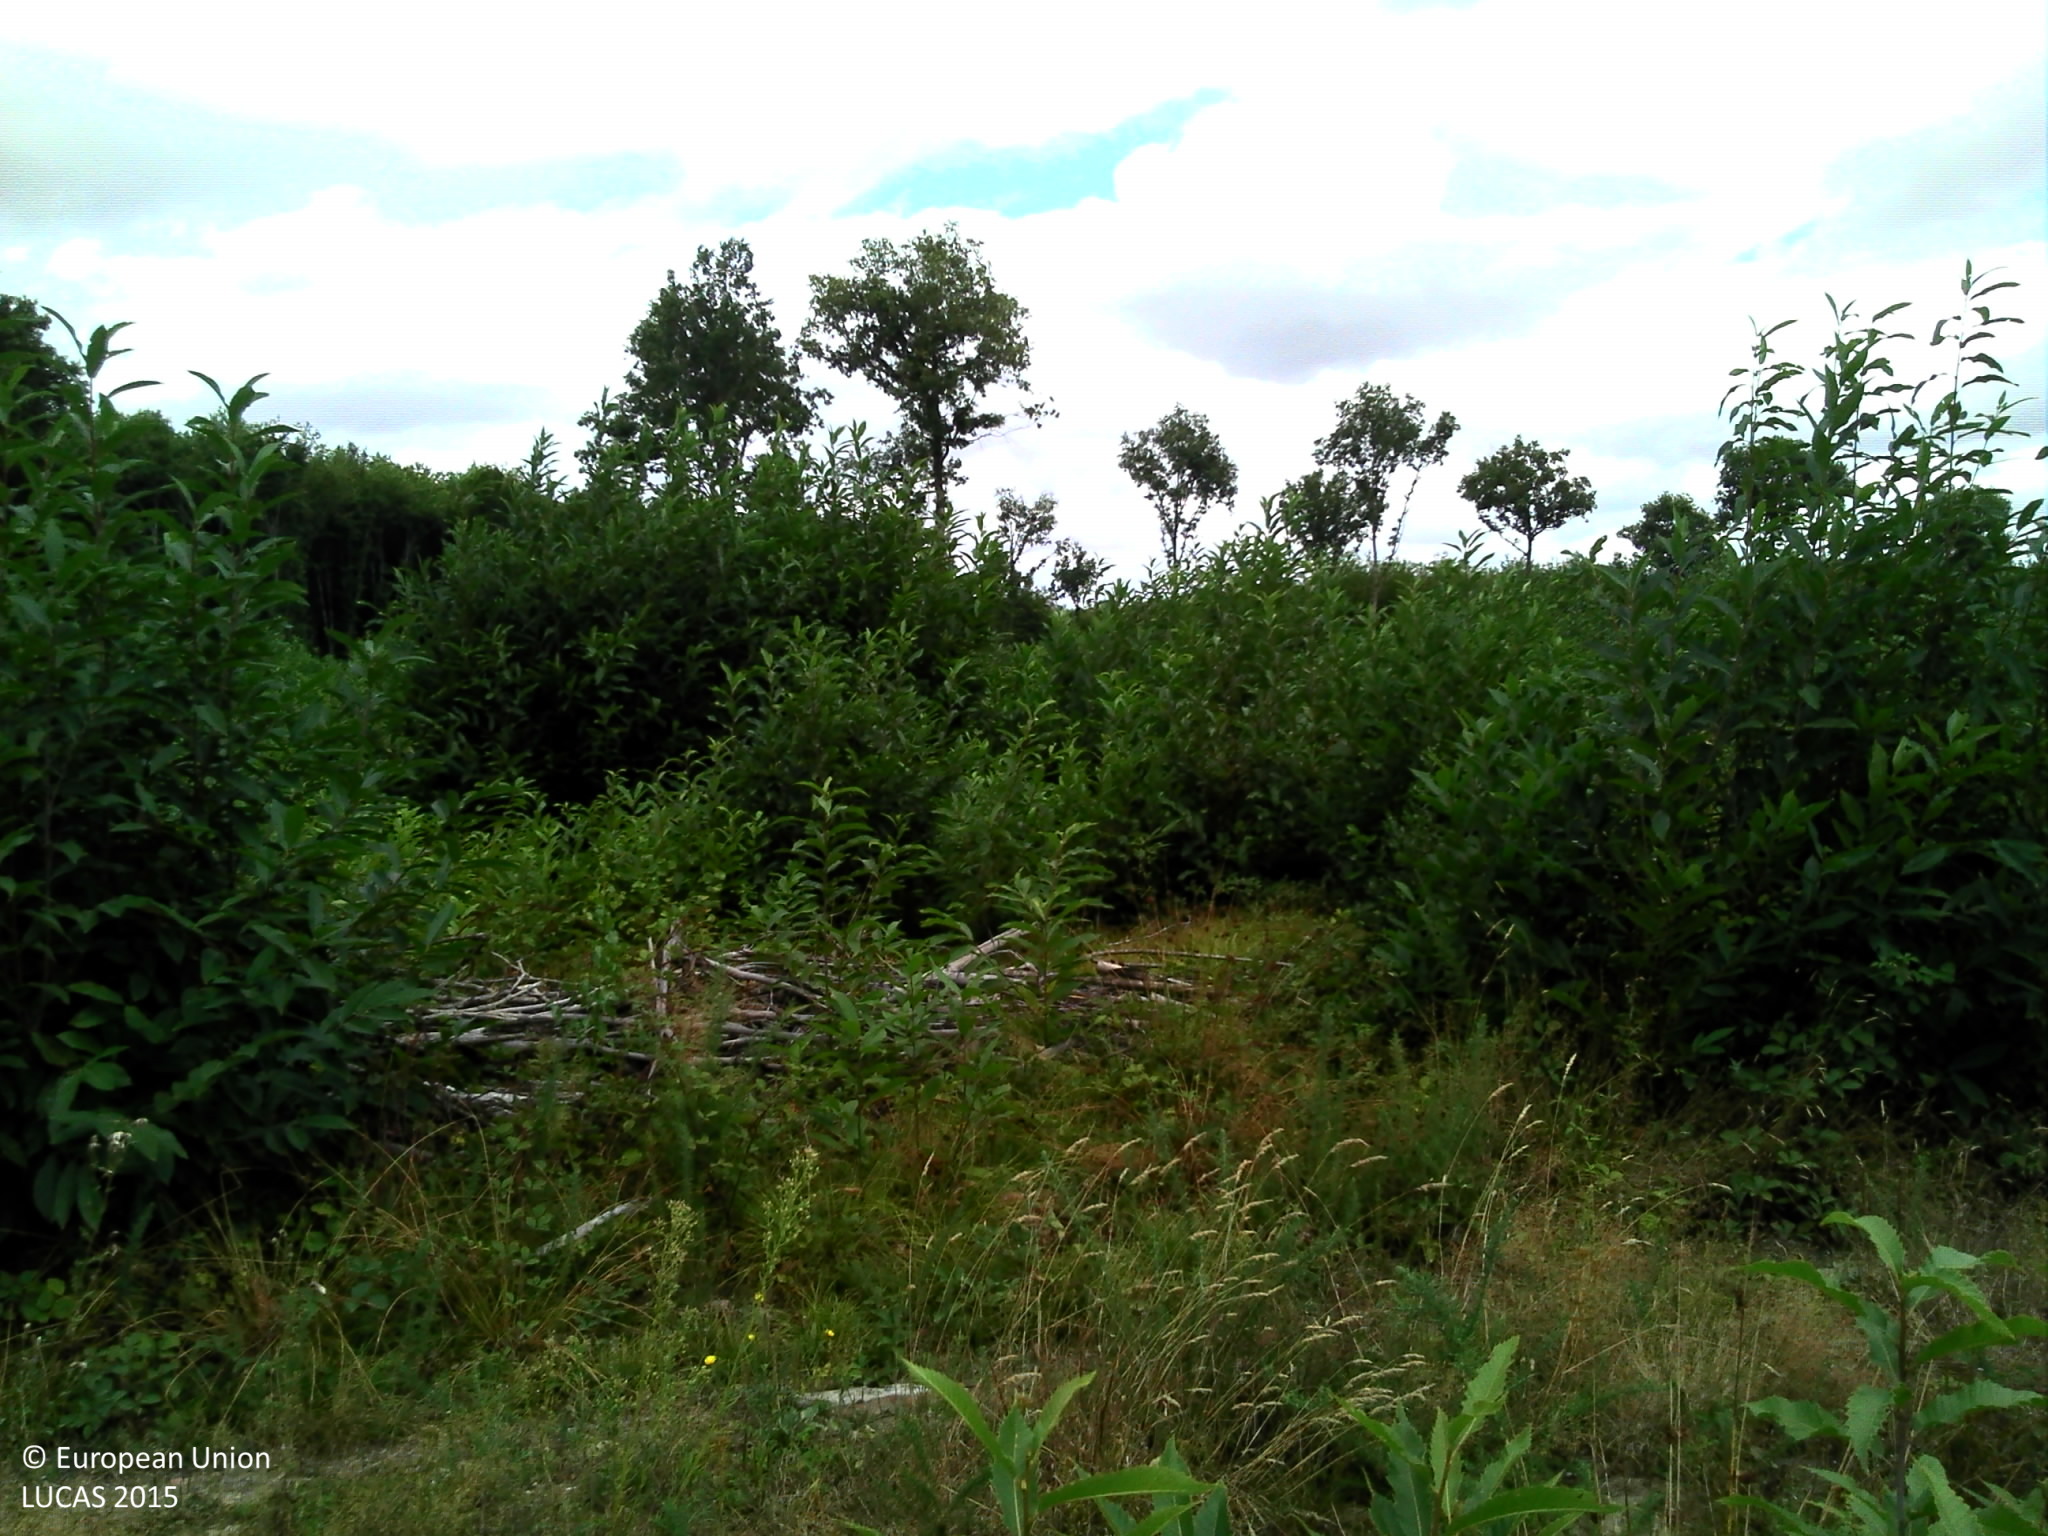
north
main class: Woodland
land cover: Broadleaved woodland
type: acidophilous oak and oak-birch forest
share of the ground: > 75 %
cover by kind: broadleaved forest trees 85 %, herbaceous plants 10 %, shrubs 5 %
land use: Forestry
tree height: < 5 m
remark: Clear cut
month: August
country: FR
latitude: 46.1283
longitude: 0.3147
